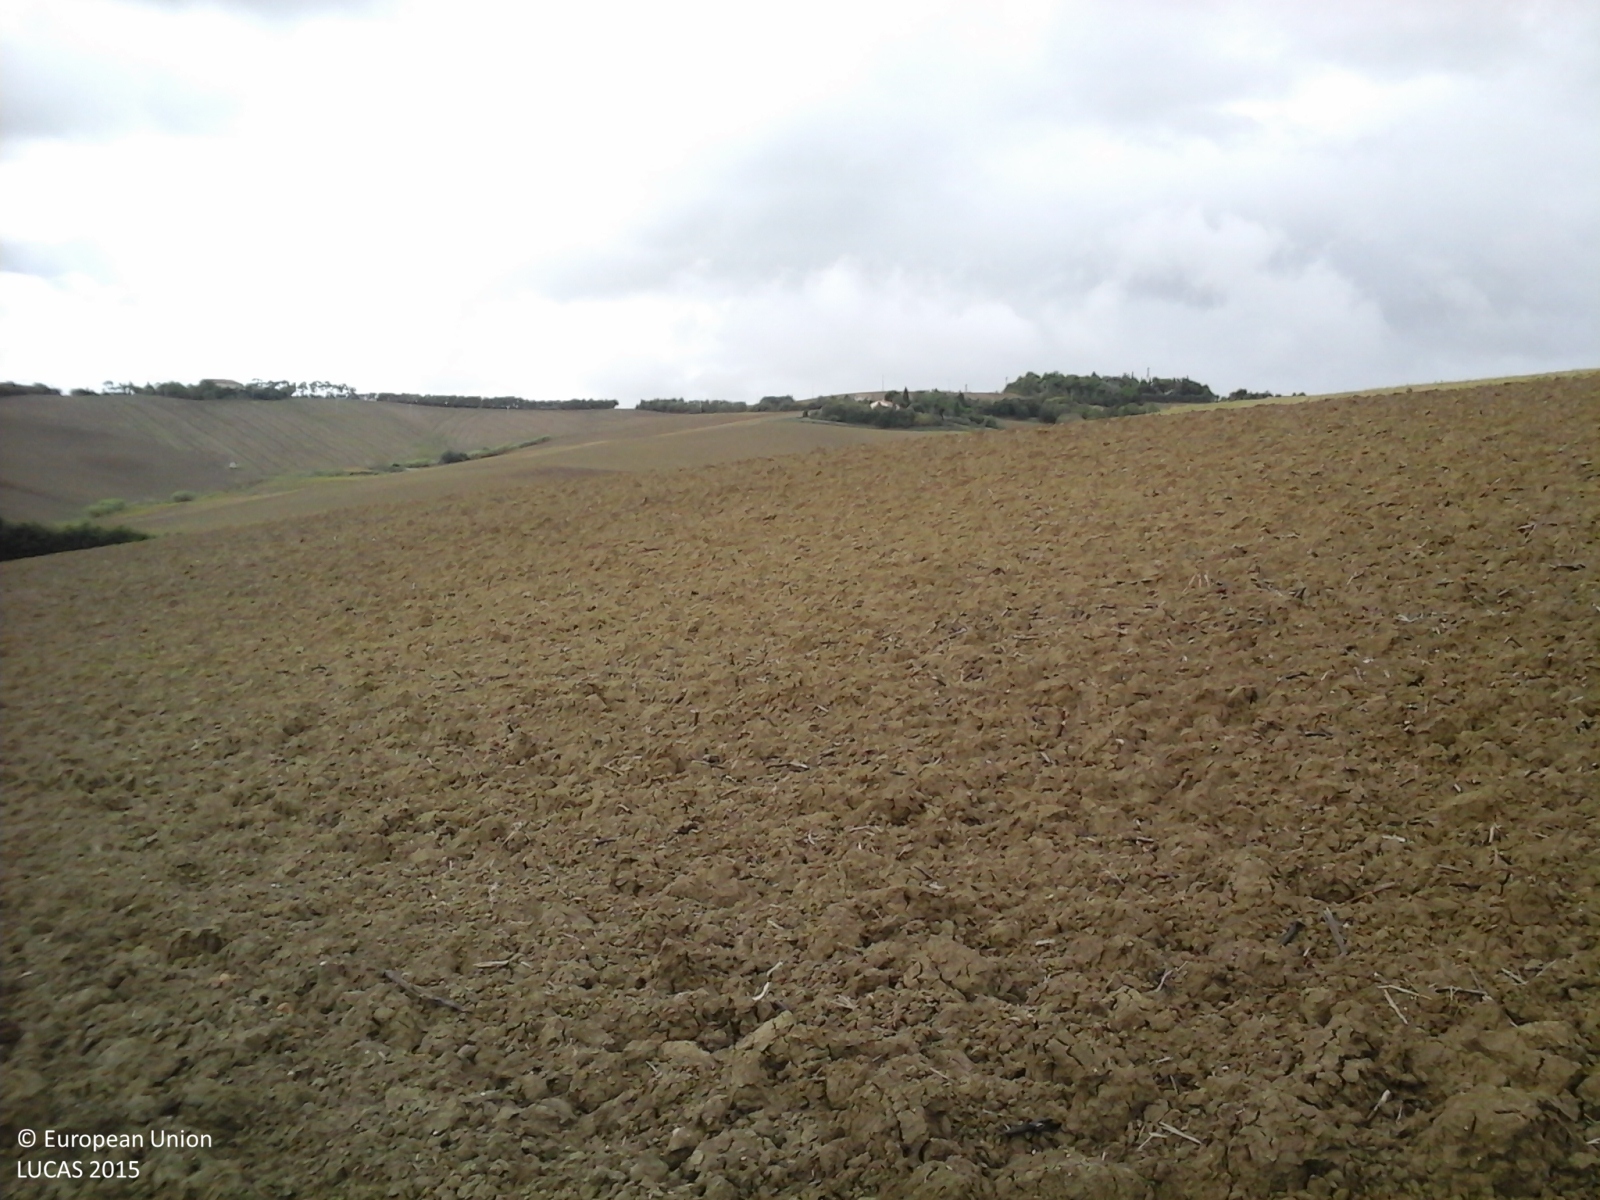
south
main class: Cropland
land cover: Sunflower
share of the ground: < 10 %
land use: Agriculture (excluding fallow land and kitchen gardens)
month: October
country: IT
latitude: 43.6865
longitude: 13.2302
